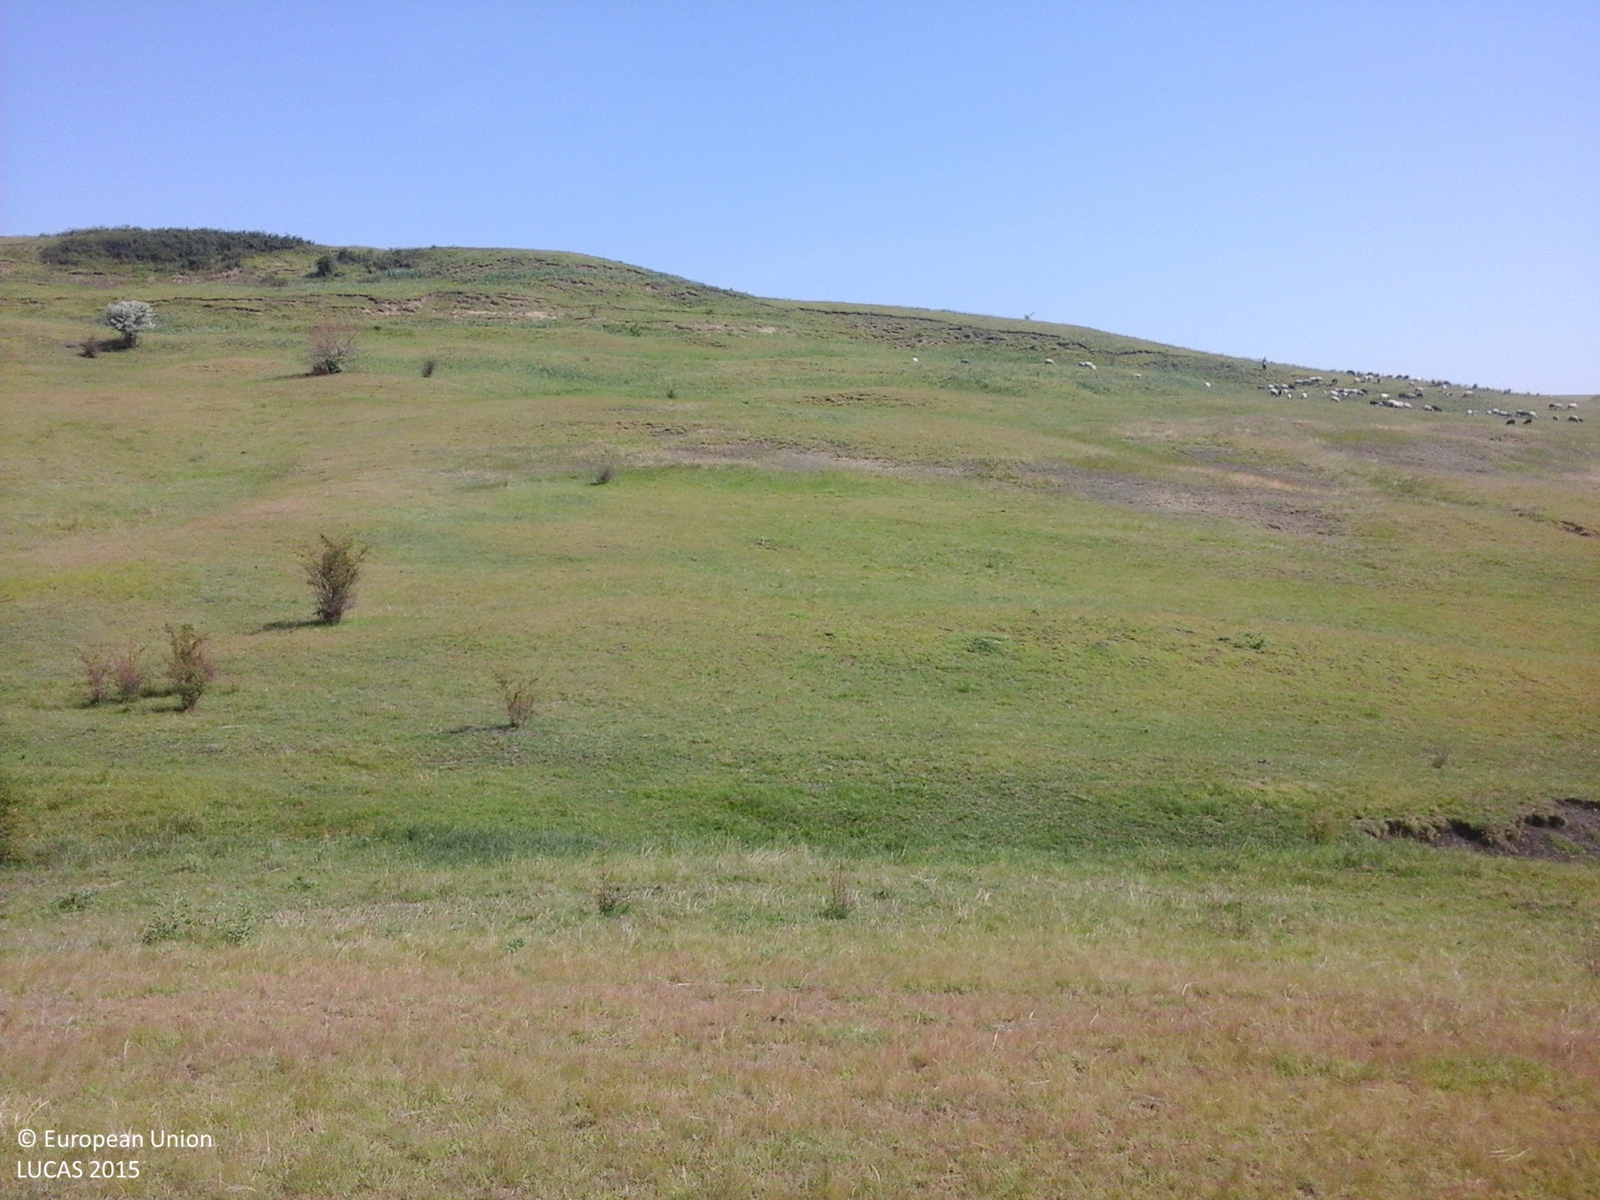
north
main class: Grassland
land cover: Grassland with sparse tree/shrub cover
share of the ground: > 75 %
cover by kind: herbaceous plants 85 %, shrubs 10 %, broadleaved forest trees 5 %
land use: Agriculture (excluding fallow land and kitchen gardens)
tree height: < 5 m
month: June
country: RO
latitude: 47.6854
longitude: 27.2026
